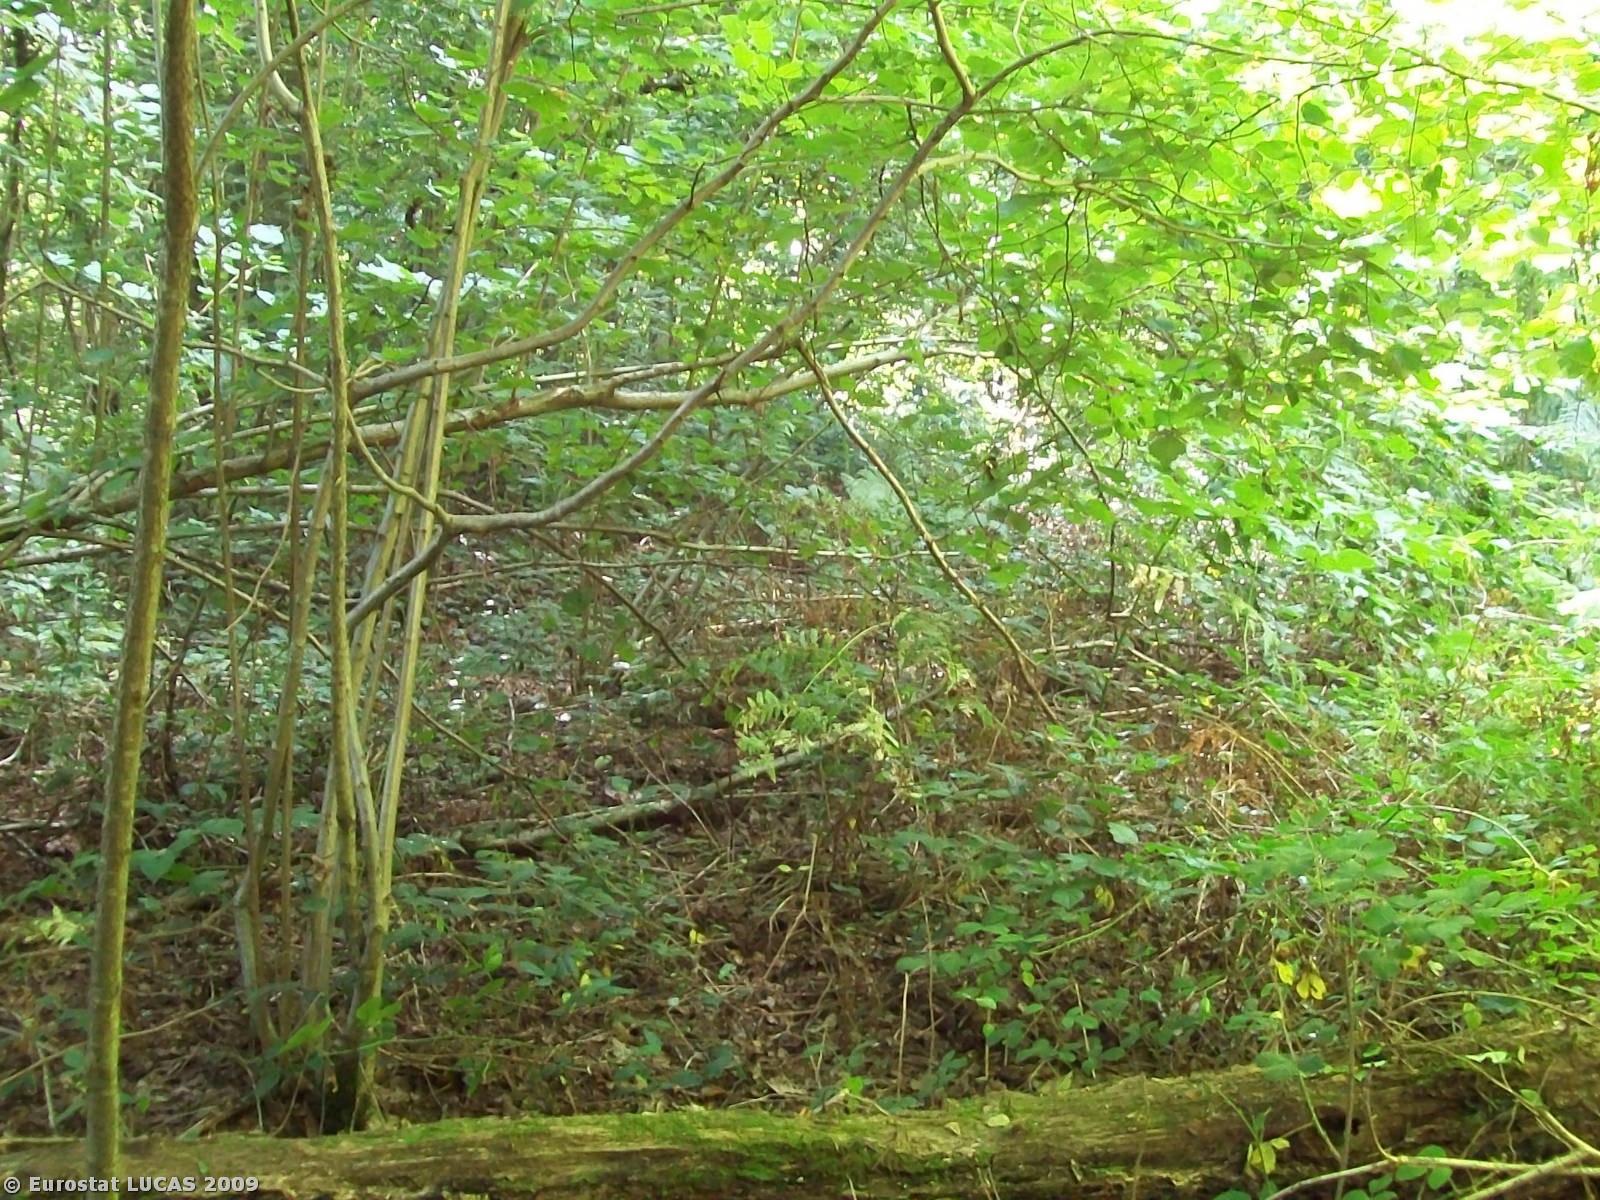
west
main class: Woodland
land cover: Broadleaved woodland
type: mesophytic deciduous forest
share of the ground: > 75 %
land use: Community services
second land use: Forestry
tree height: > 5 m
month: August
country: GB
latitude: 51.9556
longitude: -2.4488
